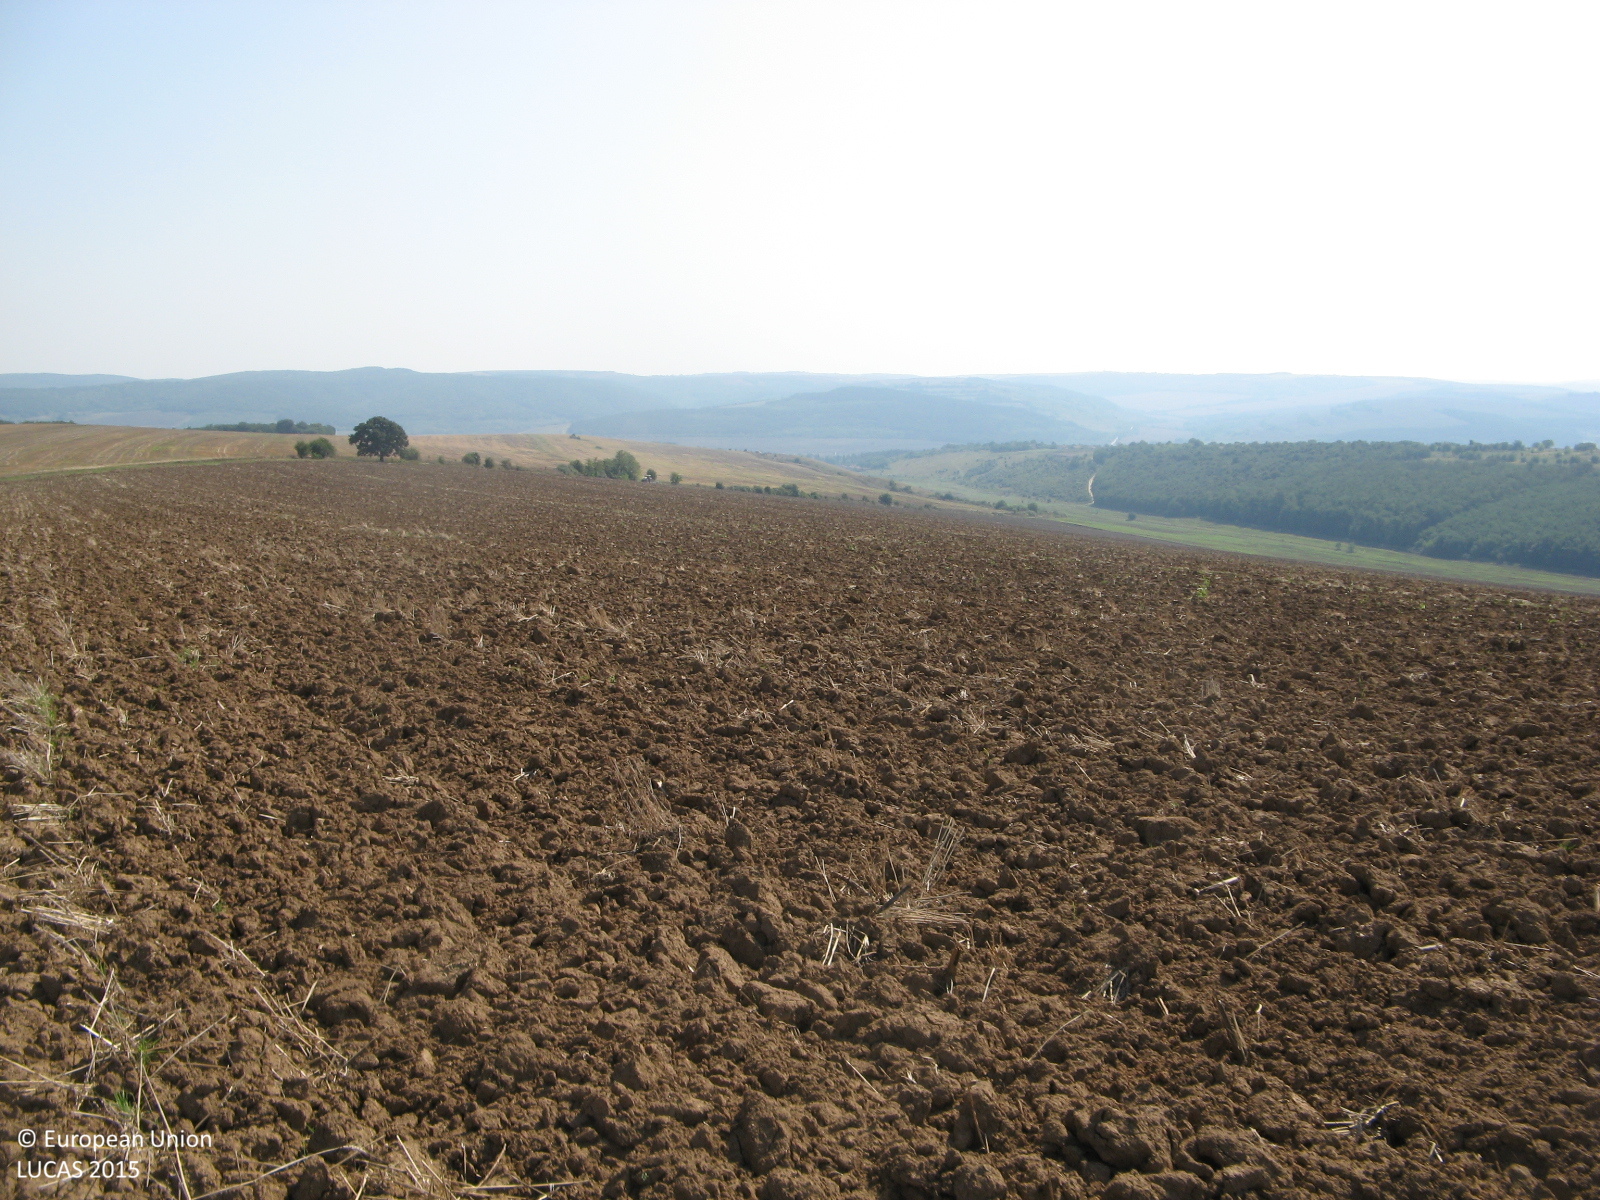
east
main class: Cropland
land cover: Common wheat
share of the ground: < 10 %
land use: Agriculture (excluding fallow land and kitchen gardens)
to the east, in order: Common wheat
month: August
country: BG
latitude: 43.4680
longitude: 25.8744
